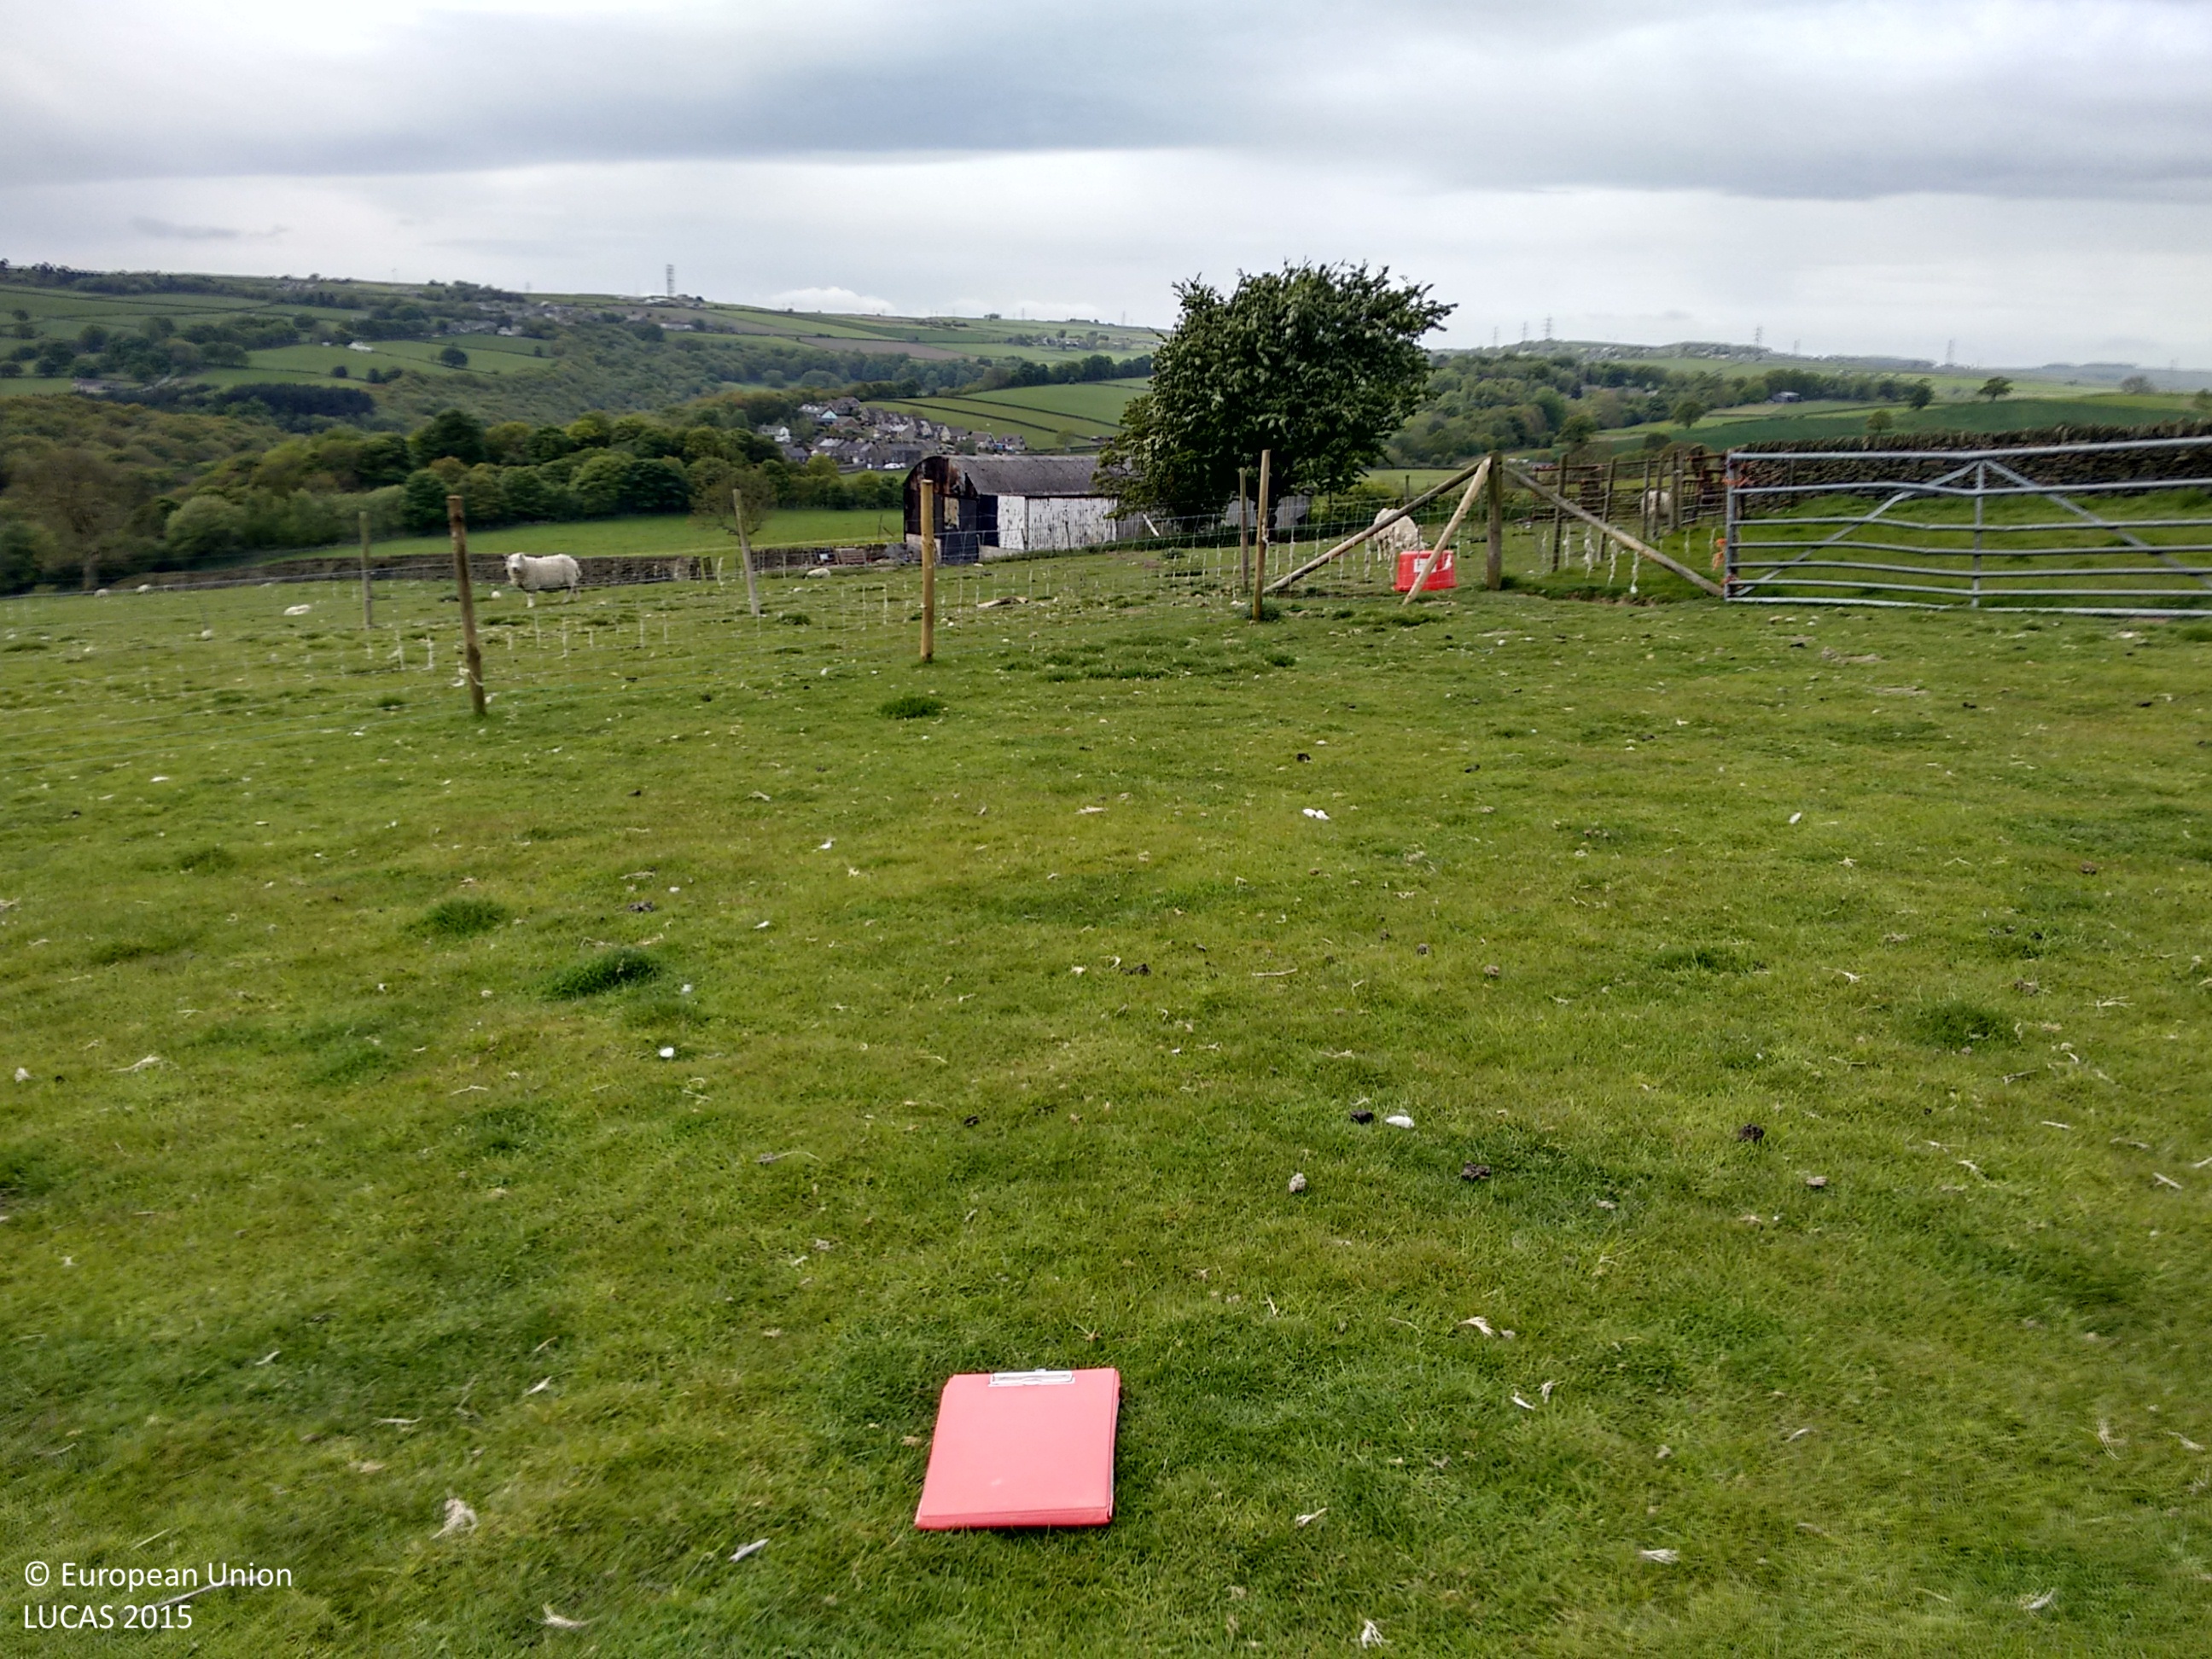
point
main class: Grassland
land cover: Grassland without tree/shrub cover
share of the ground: > 75 %
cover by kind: herbaceous plants 100 %
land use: Agriculture (excluding fallow land and kitchen gardens)
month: May
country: GB
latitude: 53.5009
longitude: -1.5537
